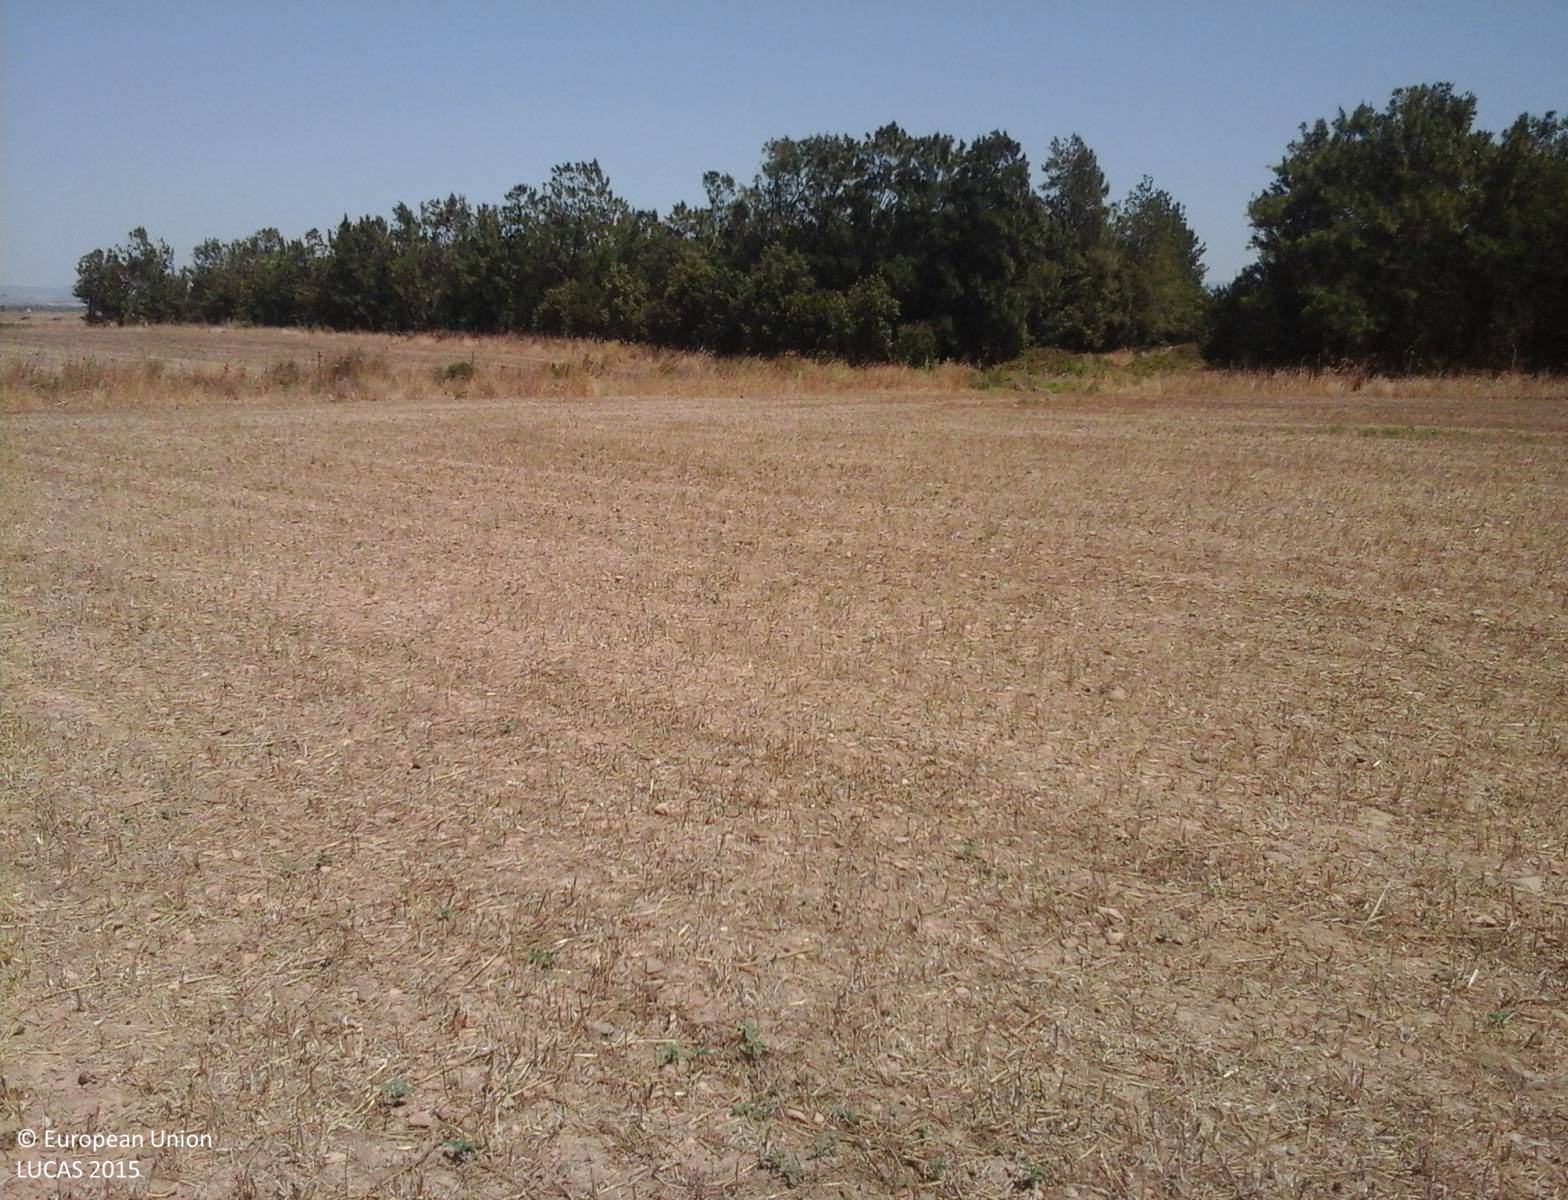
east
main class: Cropland
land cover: Mixed cereals for fodder
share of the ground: > 75 %
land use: Agriculture (excluding fallow land and kitchen gardens)
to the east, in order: Mixed cereals for fodder; Grass margins; Fences; Grassland with sparse tree/shrub cover; Pine dominated coniferous woodland; Grass margins; Fences; Mixed cereals for fodder
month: August
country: IT
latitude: 39.3737
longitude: 8.9039
